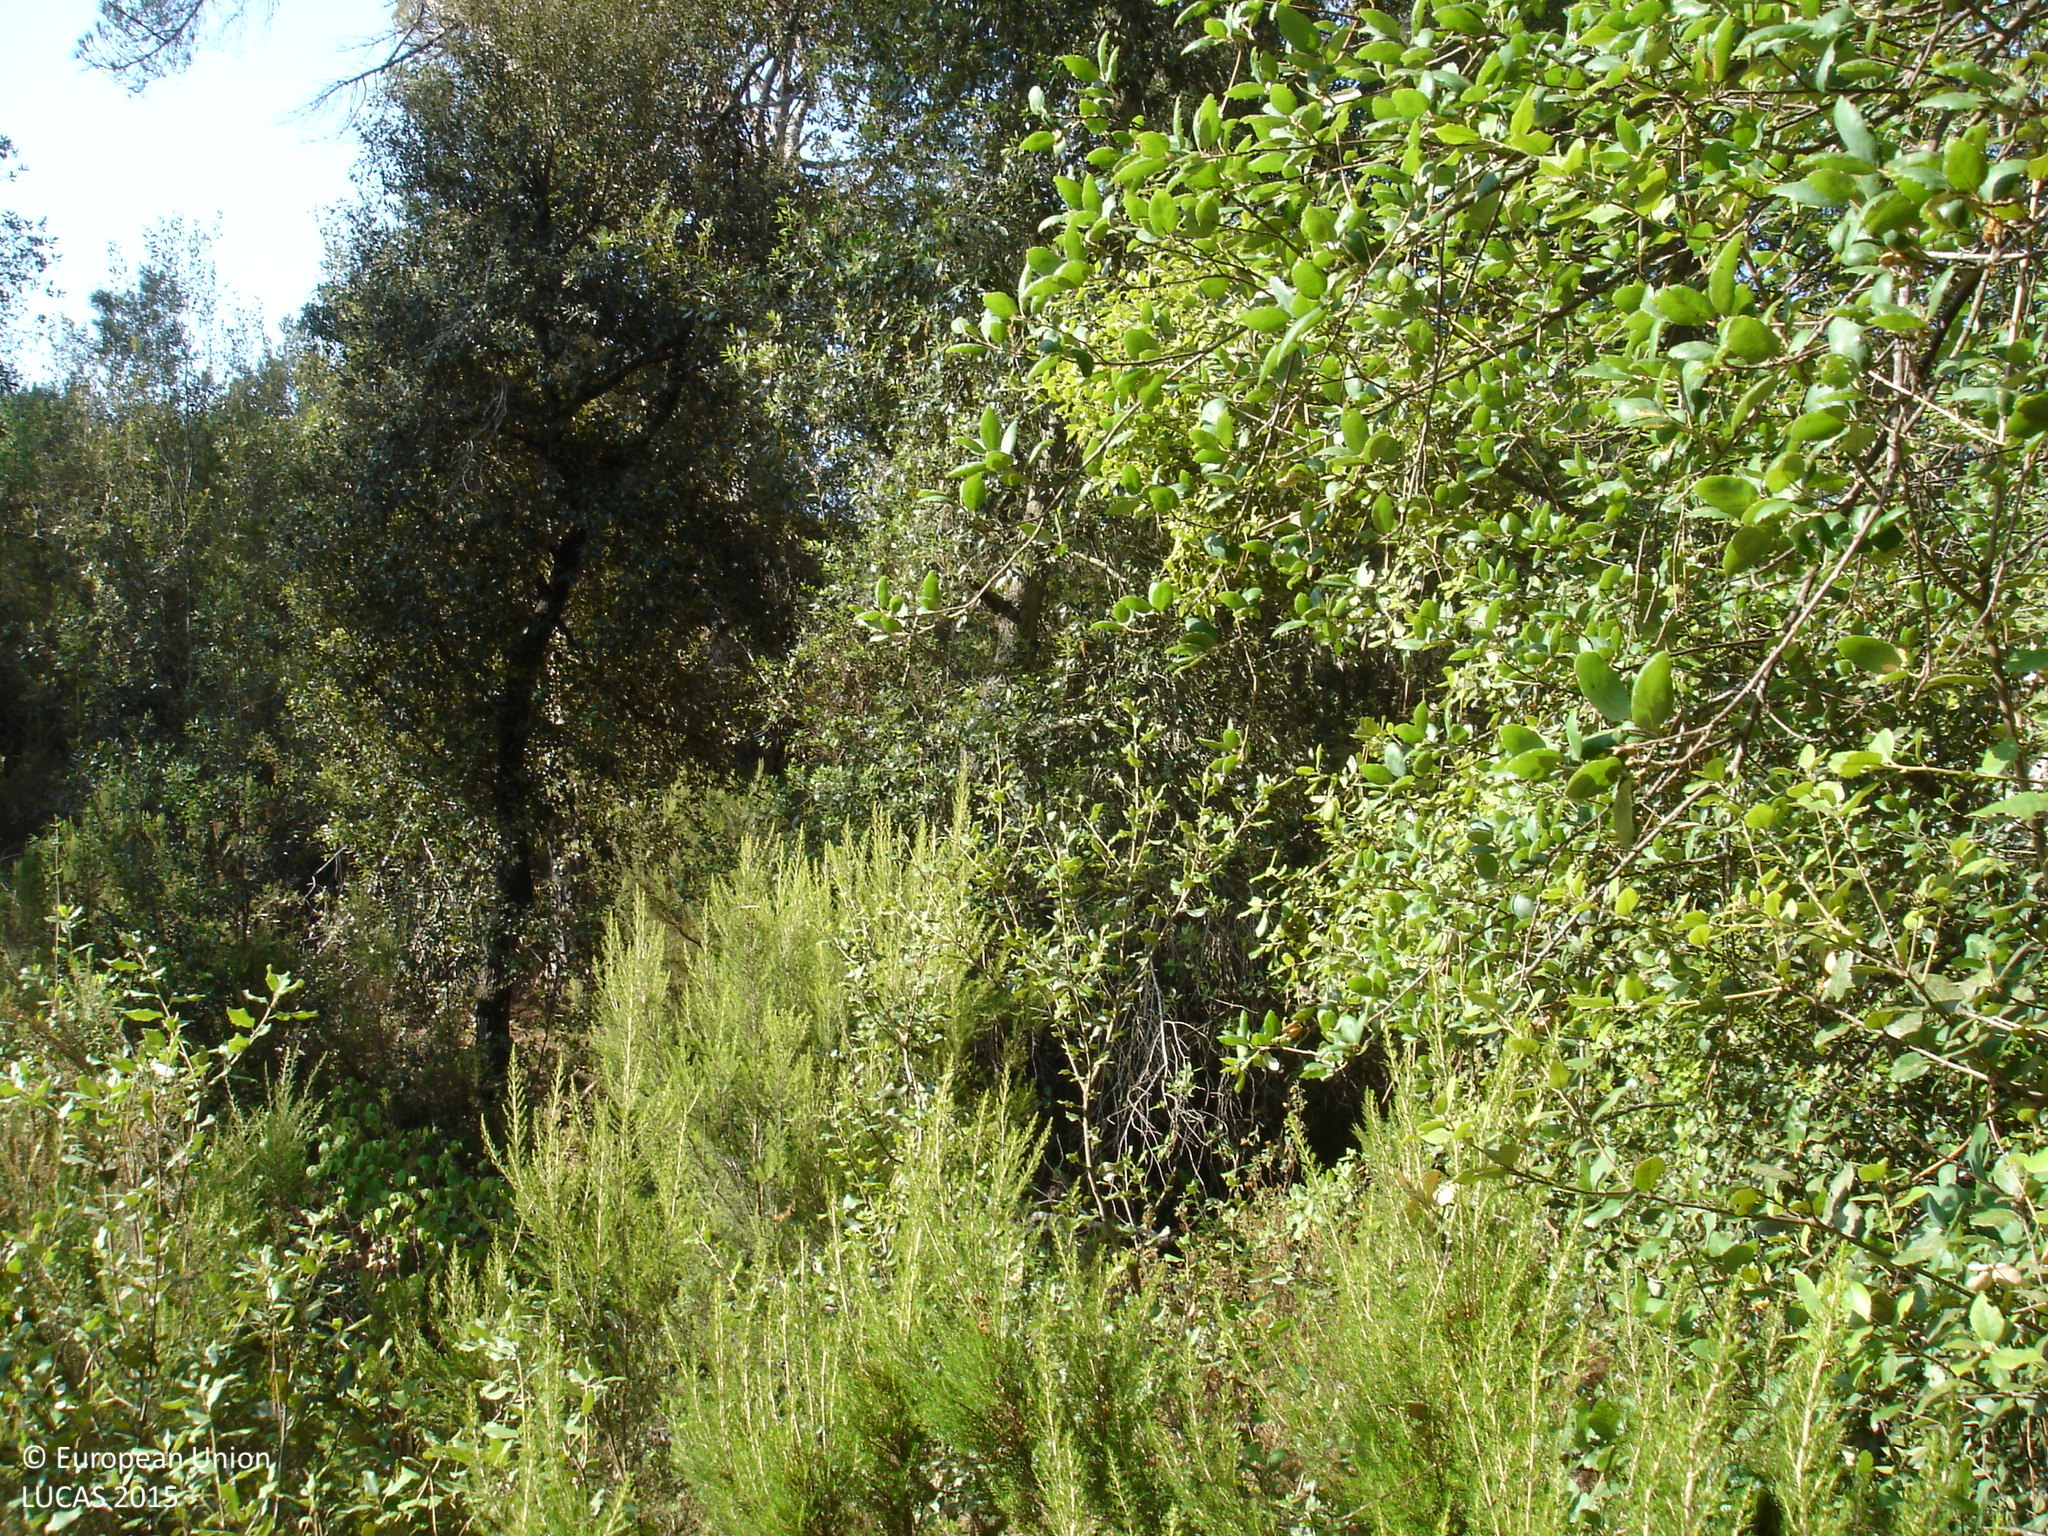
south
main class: Woodland
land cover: Other mixed woodland
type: thermophilous deciduous forest
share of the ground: > 75 %
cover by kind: broadleaved forest trees 60 %, coniferous forest trees 20 %, shrubs 15 %, herbaceous plants 5 %
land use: Forestry
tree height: > 5 m
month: July
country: ES
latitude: 41.9476
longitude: 3.1040
